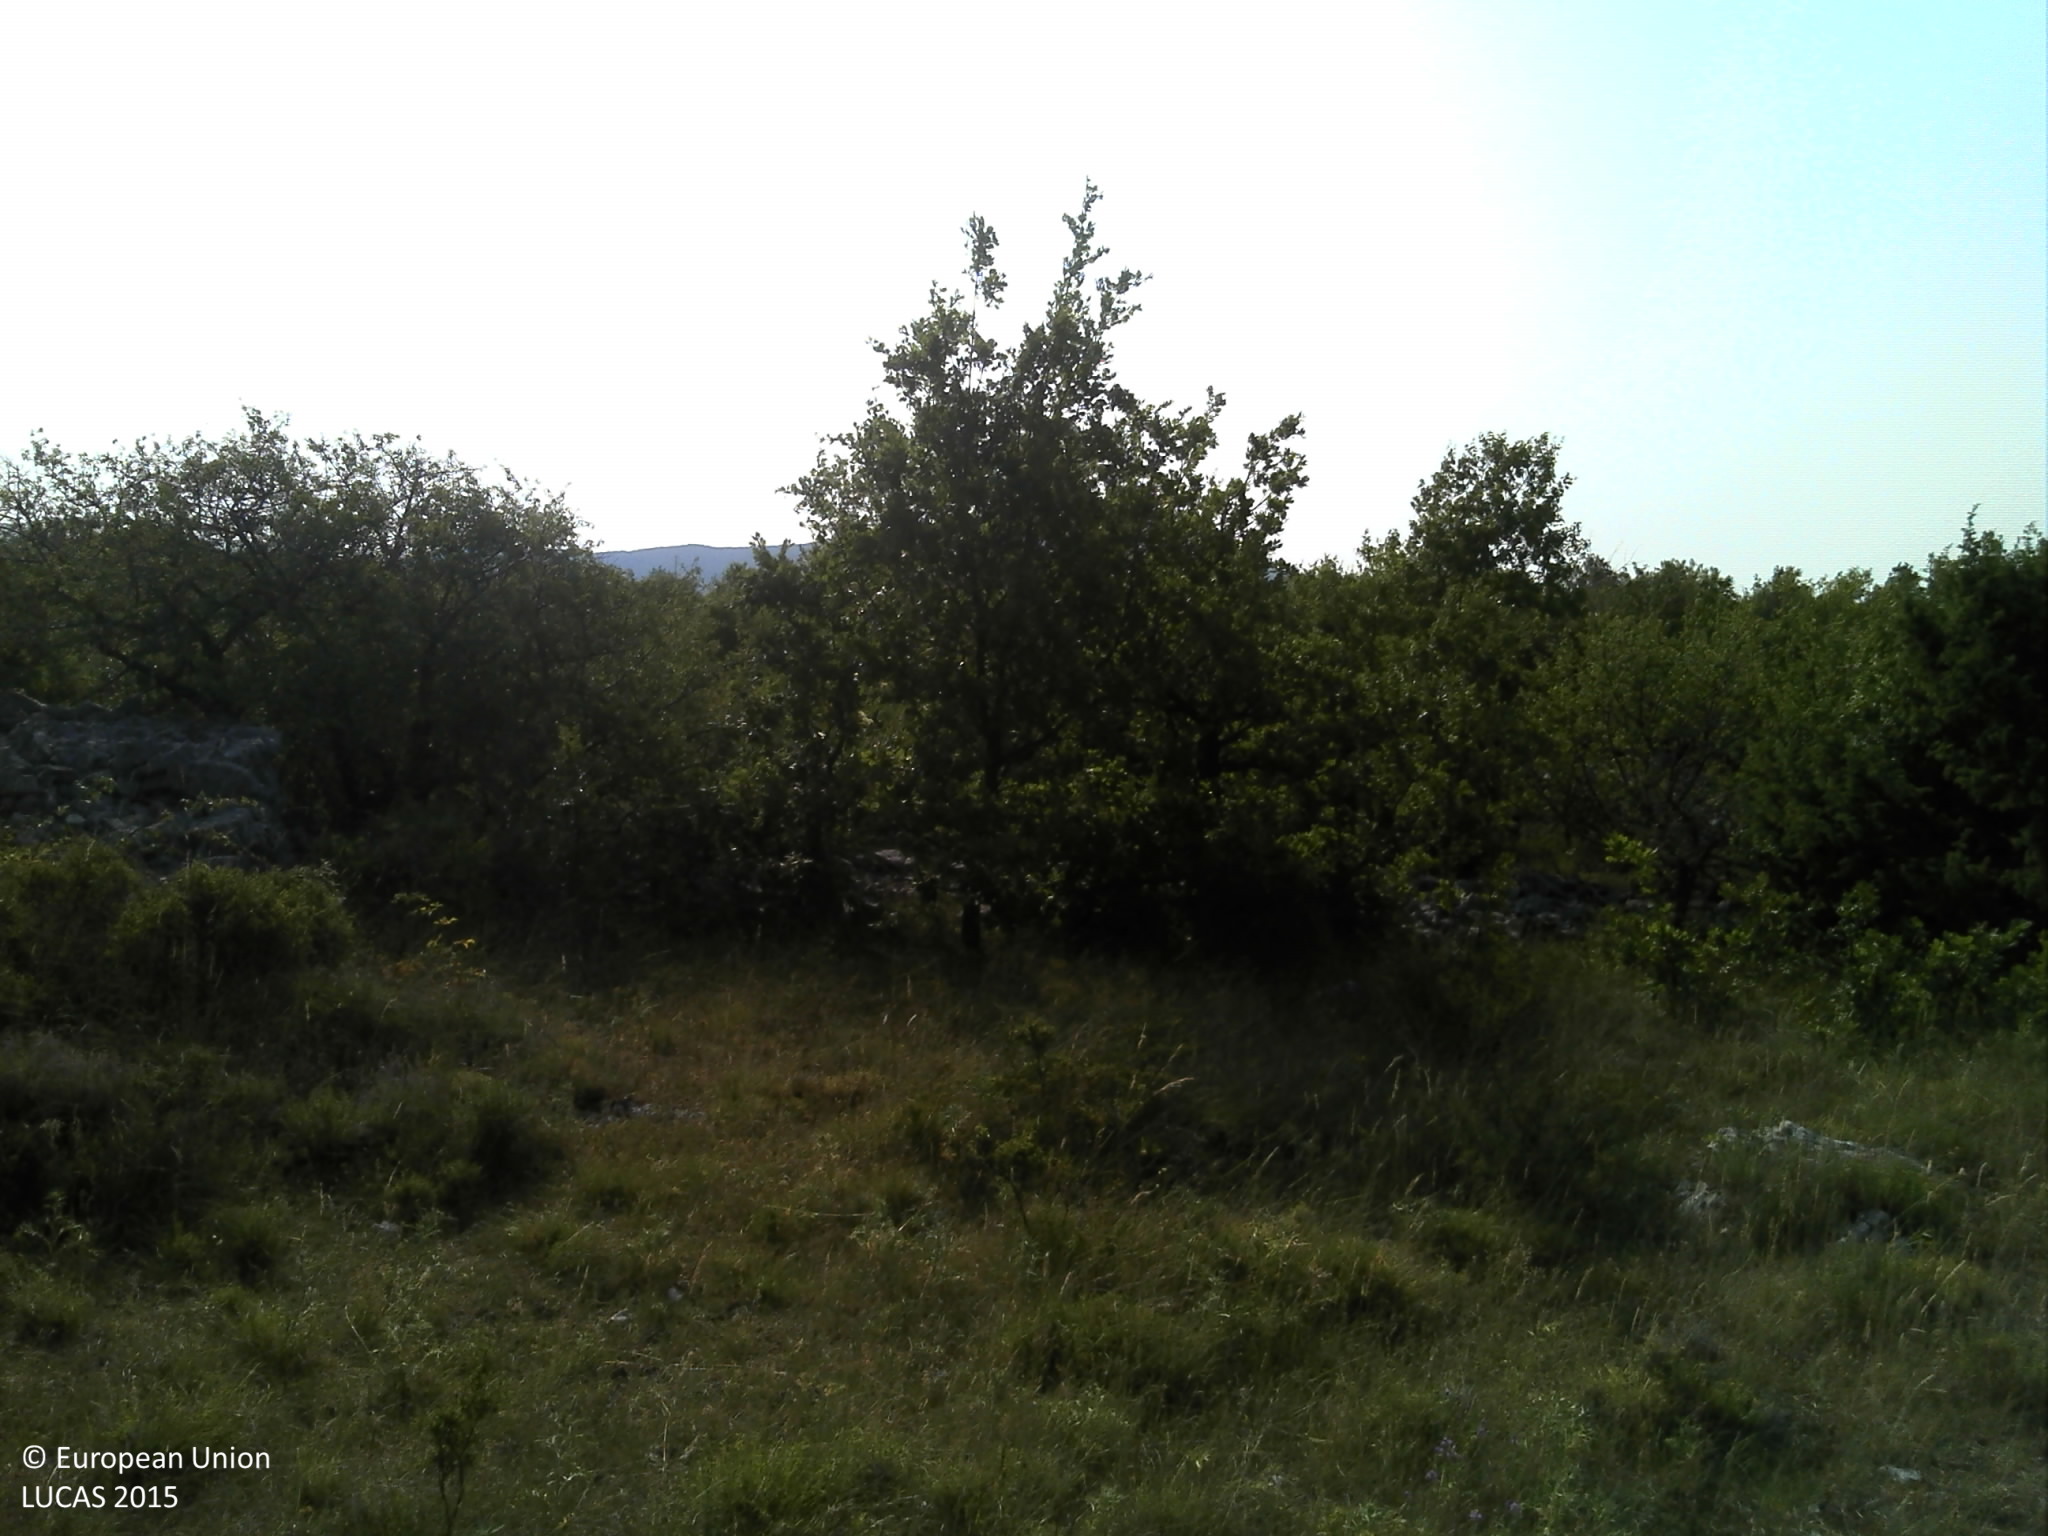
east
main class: Grassland
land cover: Grassland with sparse tree/shrub cover
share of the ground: > 75 %
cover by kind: herbaceous plants 70 %, shrubs 10 %, broadleaved forest trees 5 %, lichens and mosses 5 %, consolidated bare surface 5 %, unconsolidated bare surface 5 %
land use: Abandoned areas
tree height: > 5 m
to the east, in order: Grassland with sparse tree/shrub cover; Dry stone walls; Grassland with sparse tree/shrub cover; Dry stone walls; Other mixed woodland; Dry stone walls; Grassland with sparse tree/shrub cover; Dry stone walls; Grassland with sparse tree/shrub cover
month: July
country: HR
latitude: 43.4674
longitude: 16.9258
